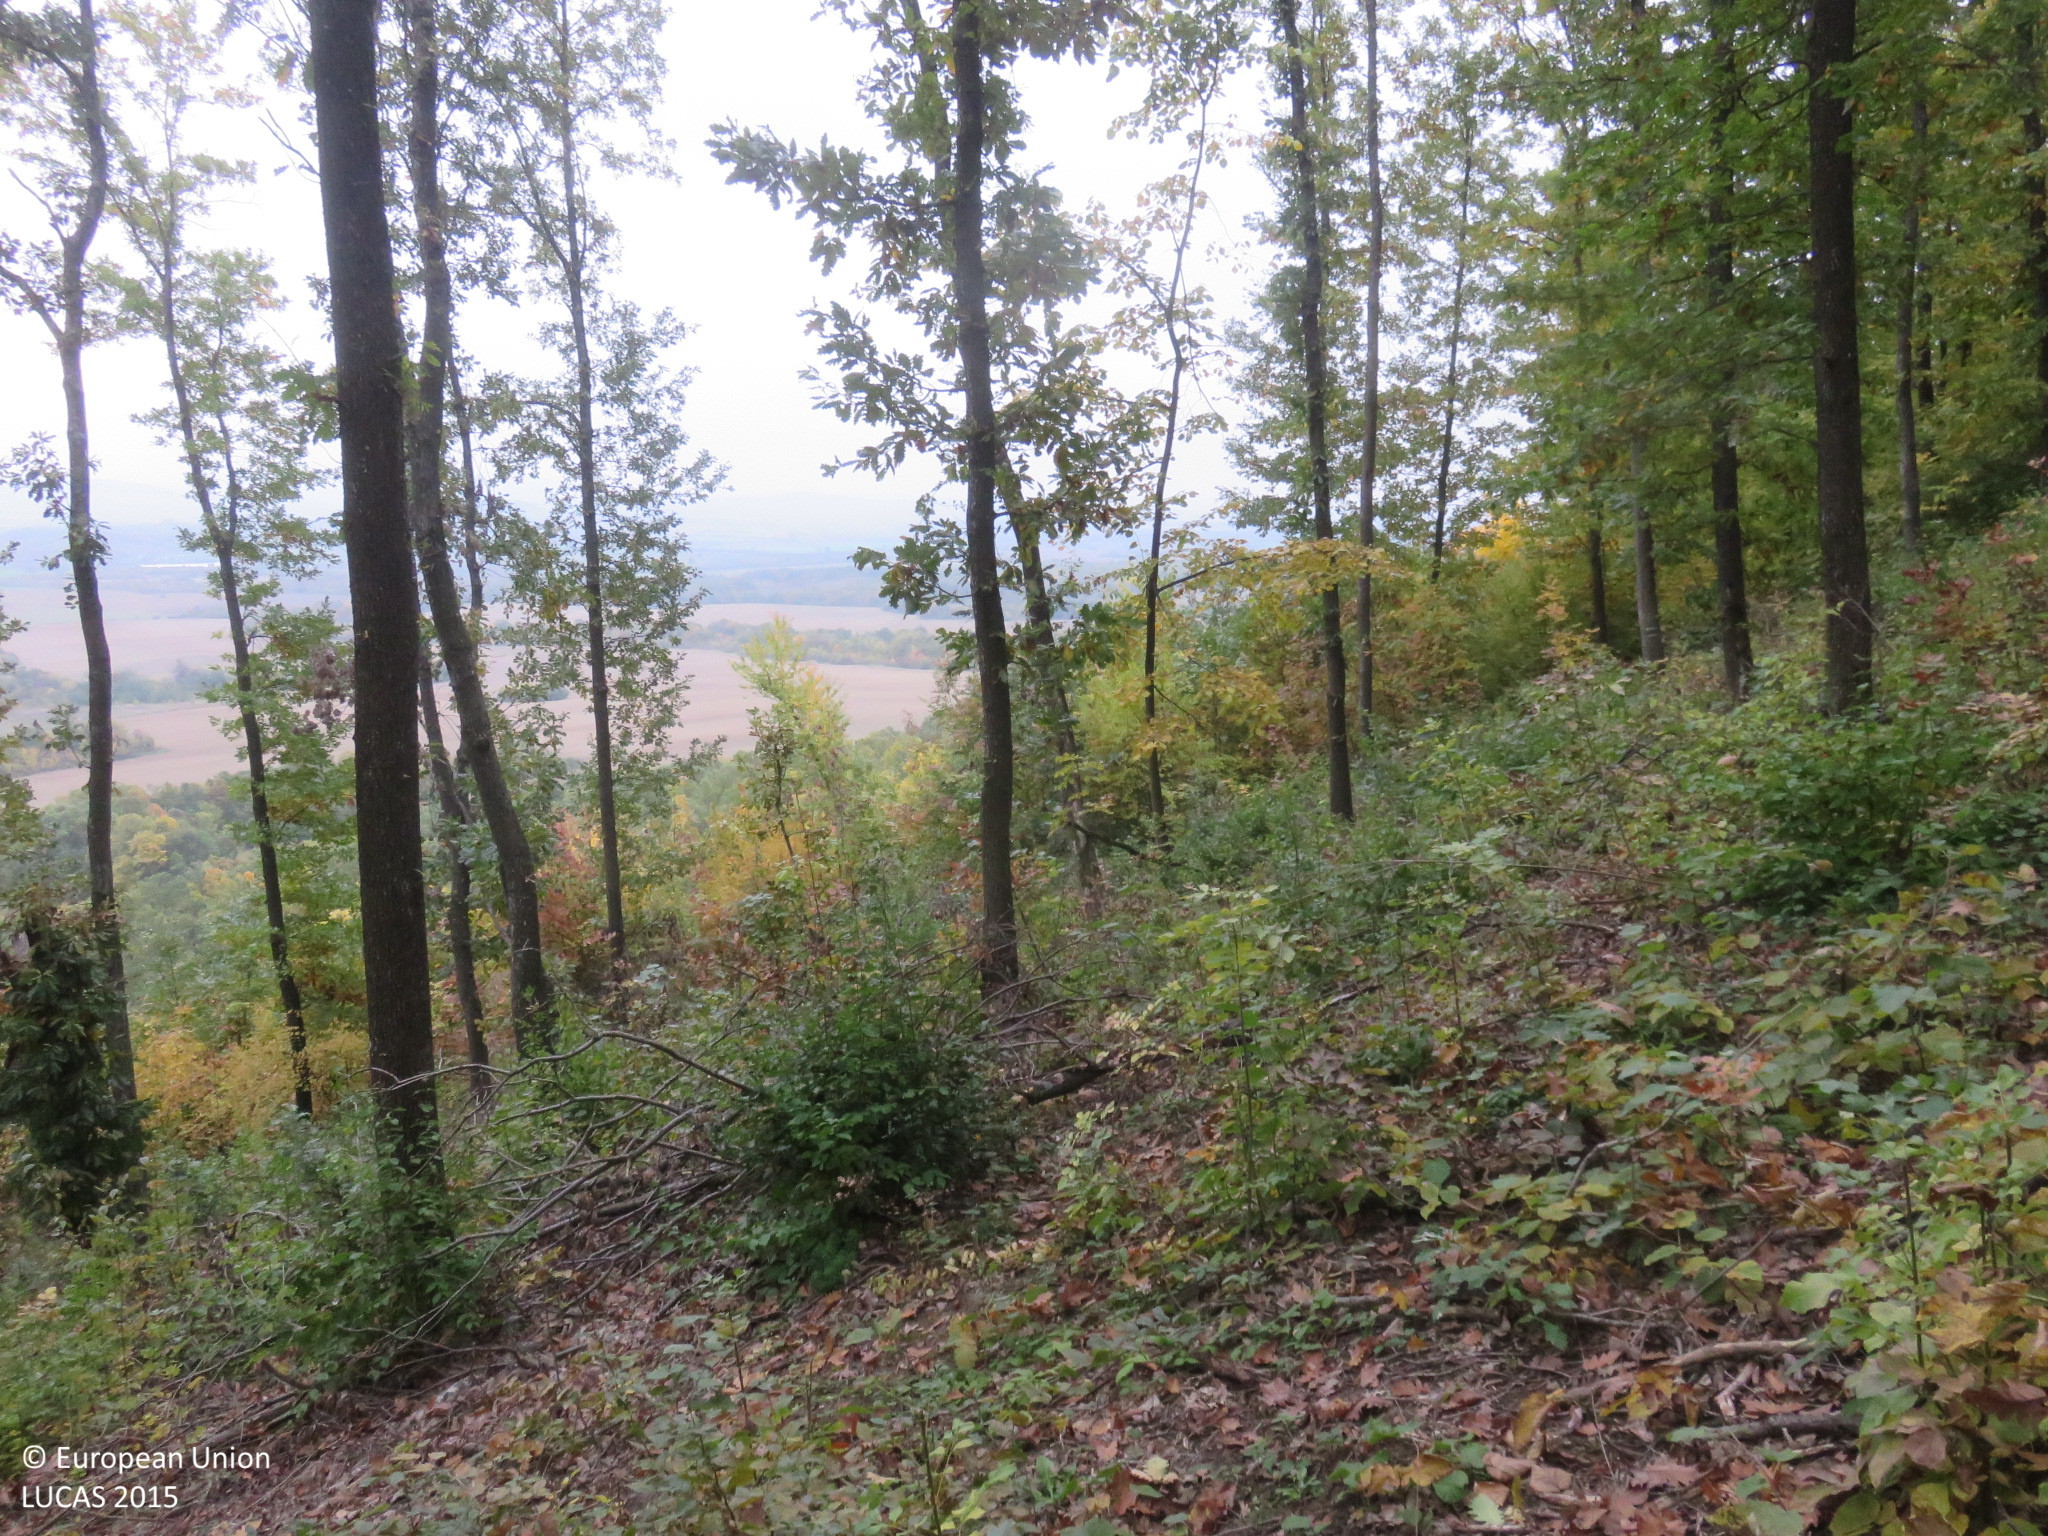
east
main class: Woodland
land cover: Broadleaved woodland
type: mesophytic deciduous forest
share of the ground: > 75 %
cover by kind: broadleaved forest trees 80 %, shrubs 10 %, herbaceous plants 10 %
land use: Forestry
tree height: > 5 m
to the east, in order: Broadleaved woodland
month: October
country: BG
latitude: 42.9443
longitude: 24.9800
